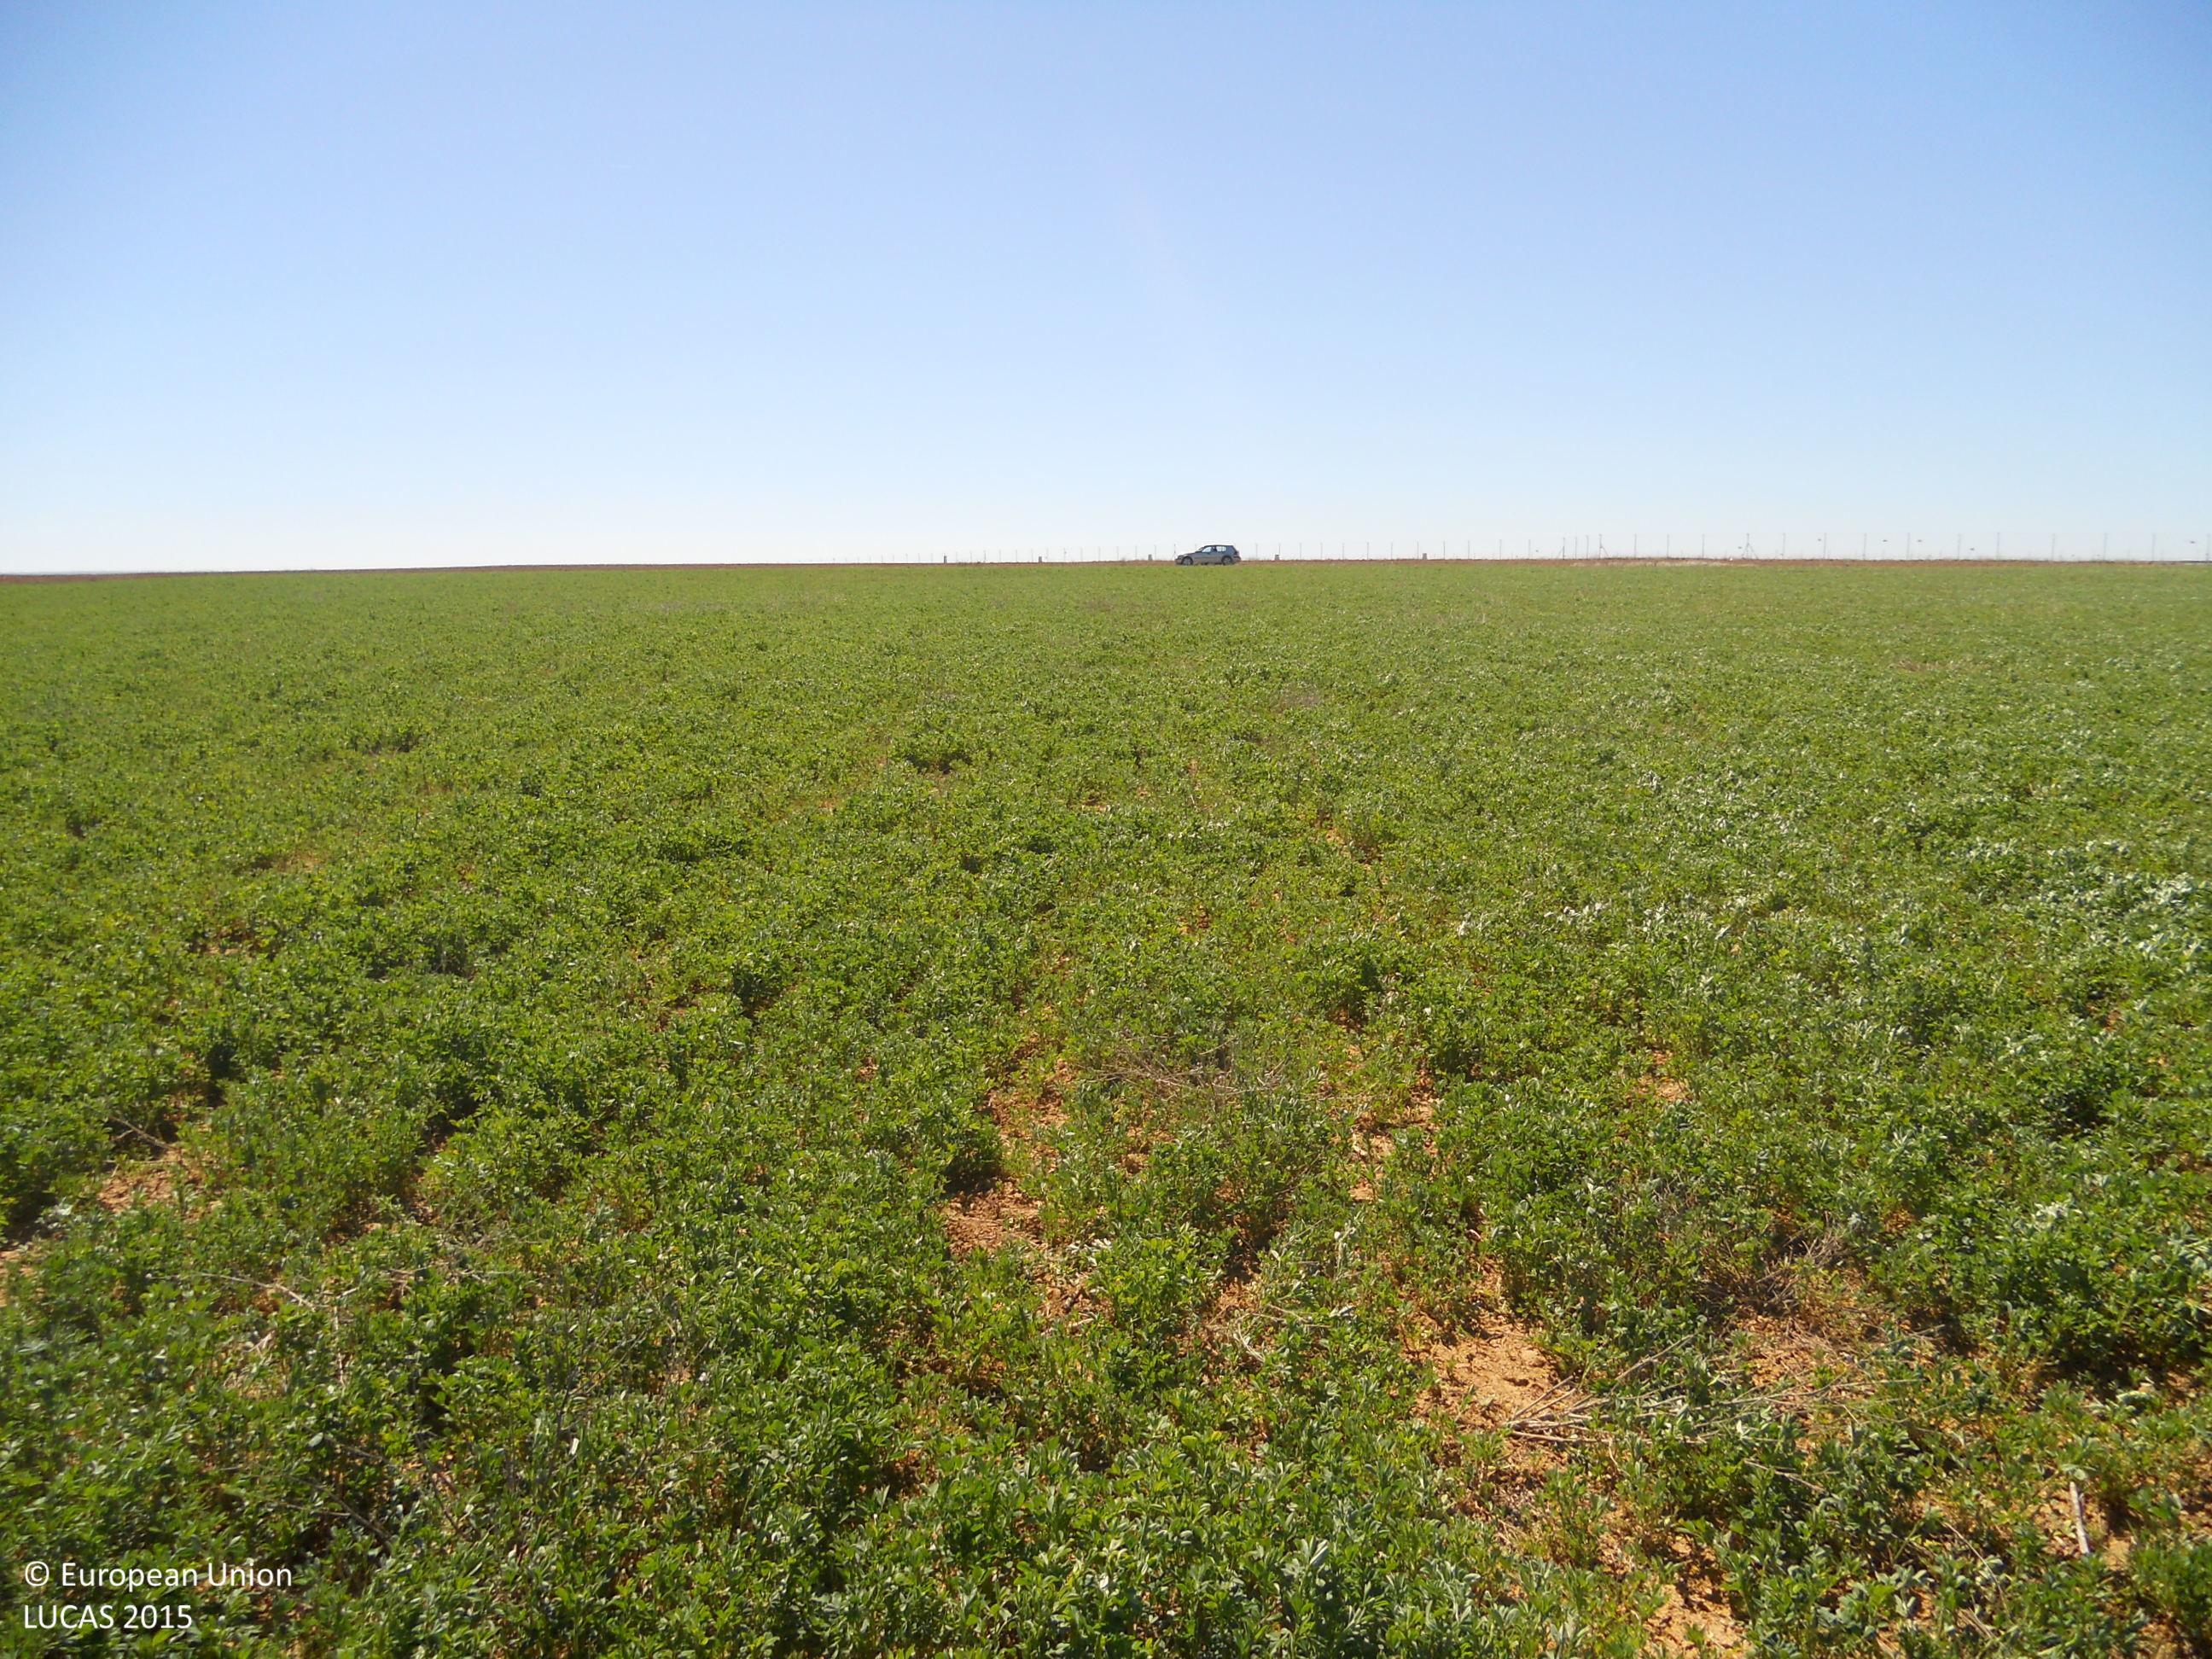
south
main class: Cropland
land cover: Lucerne
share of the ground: > 75 %
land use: Agriculture (excluding fallow land and kitchen gardens)
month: April
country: ES
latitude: 42.2167
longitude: -4.8205
